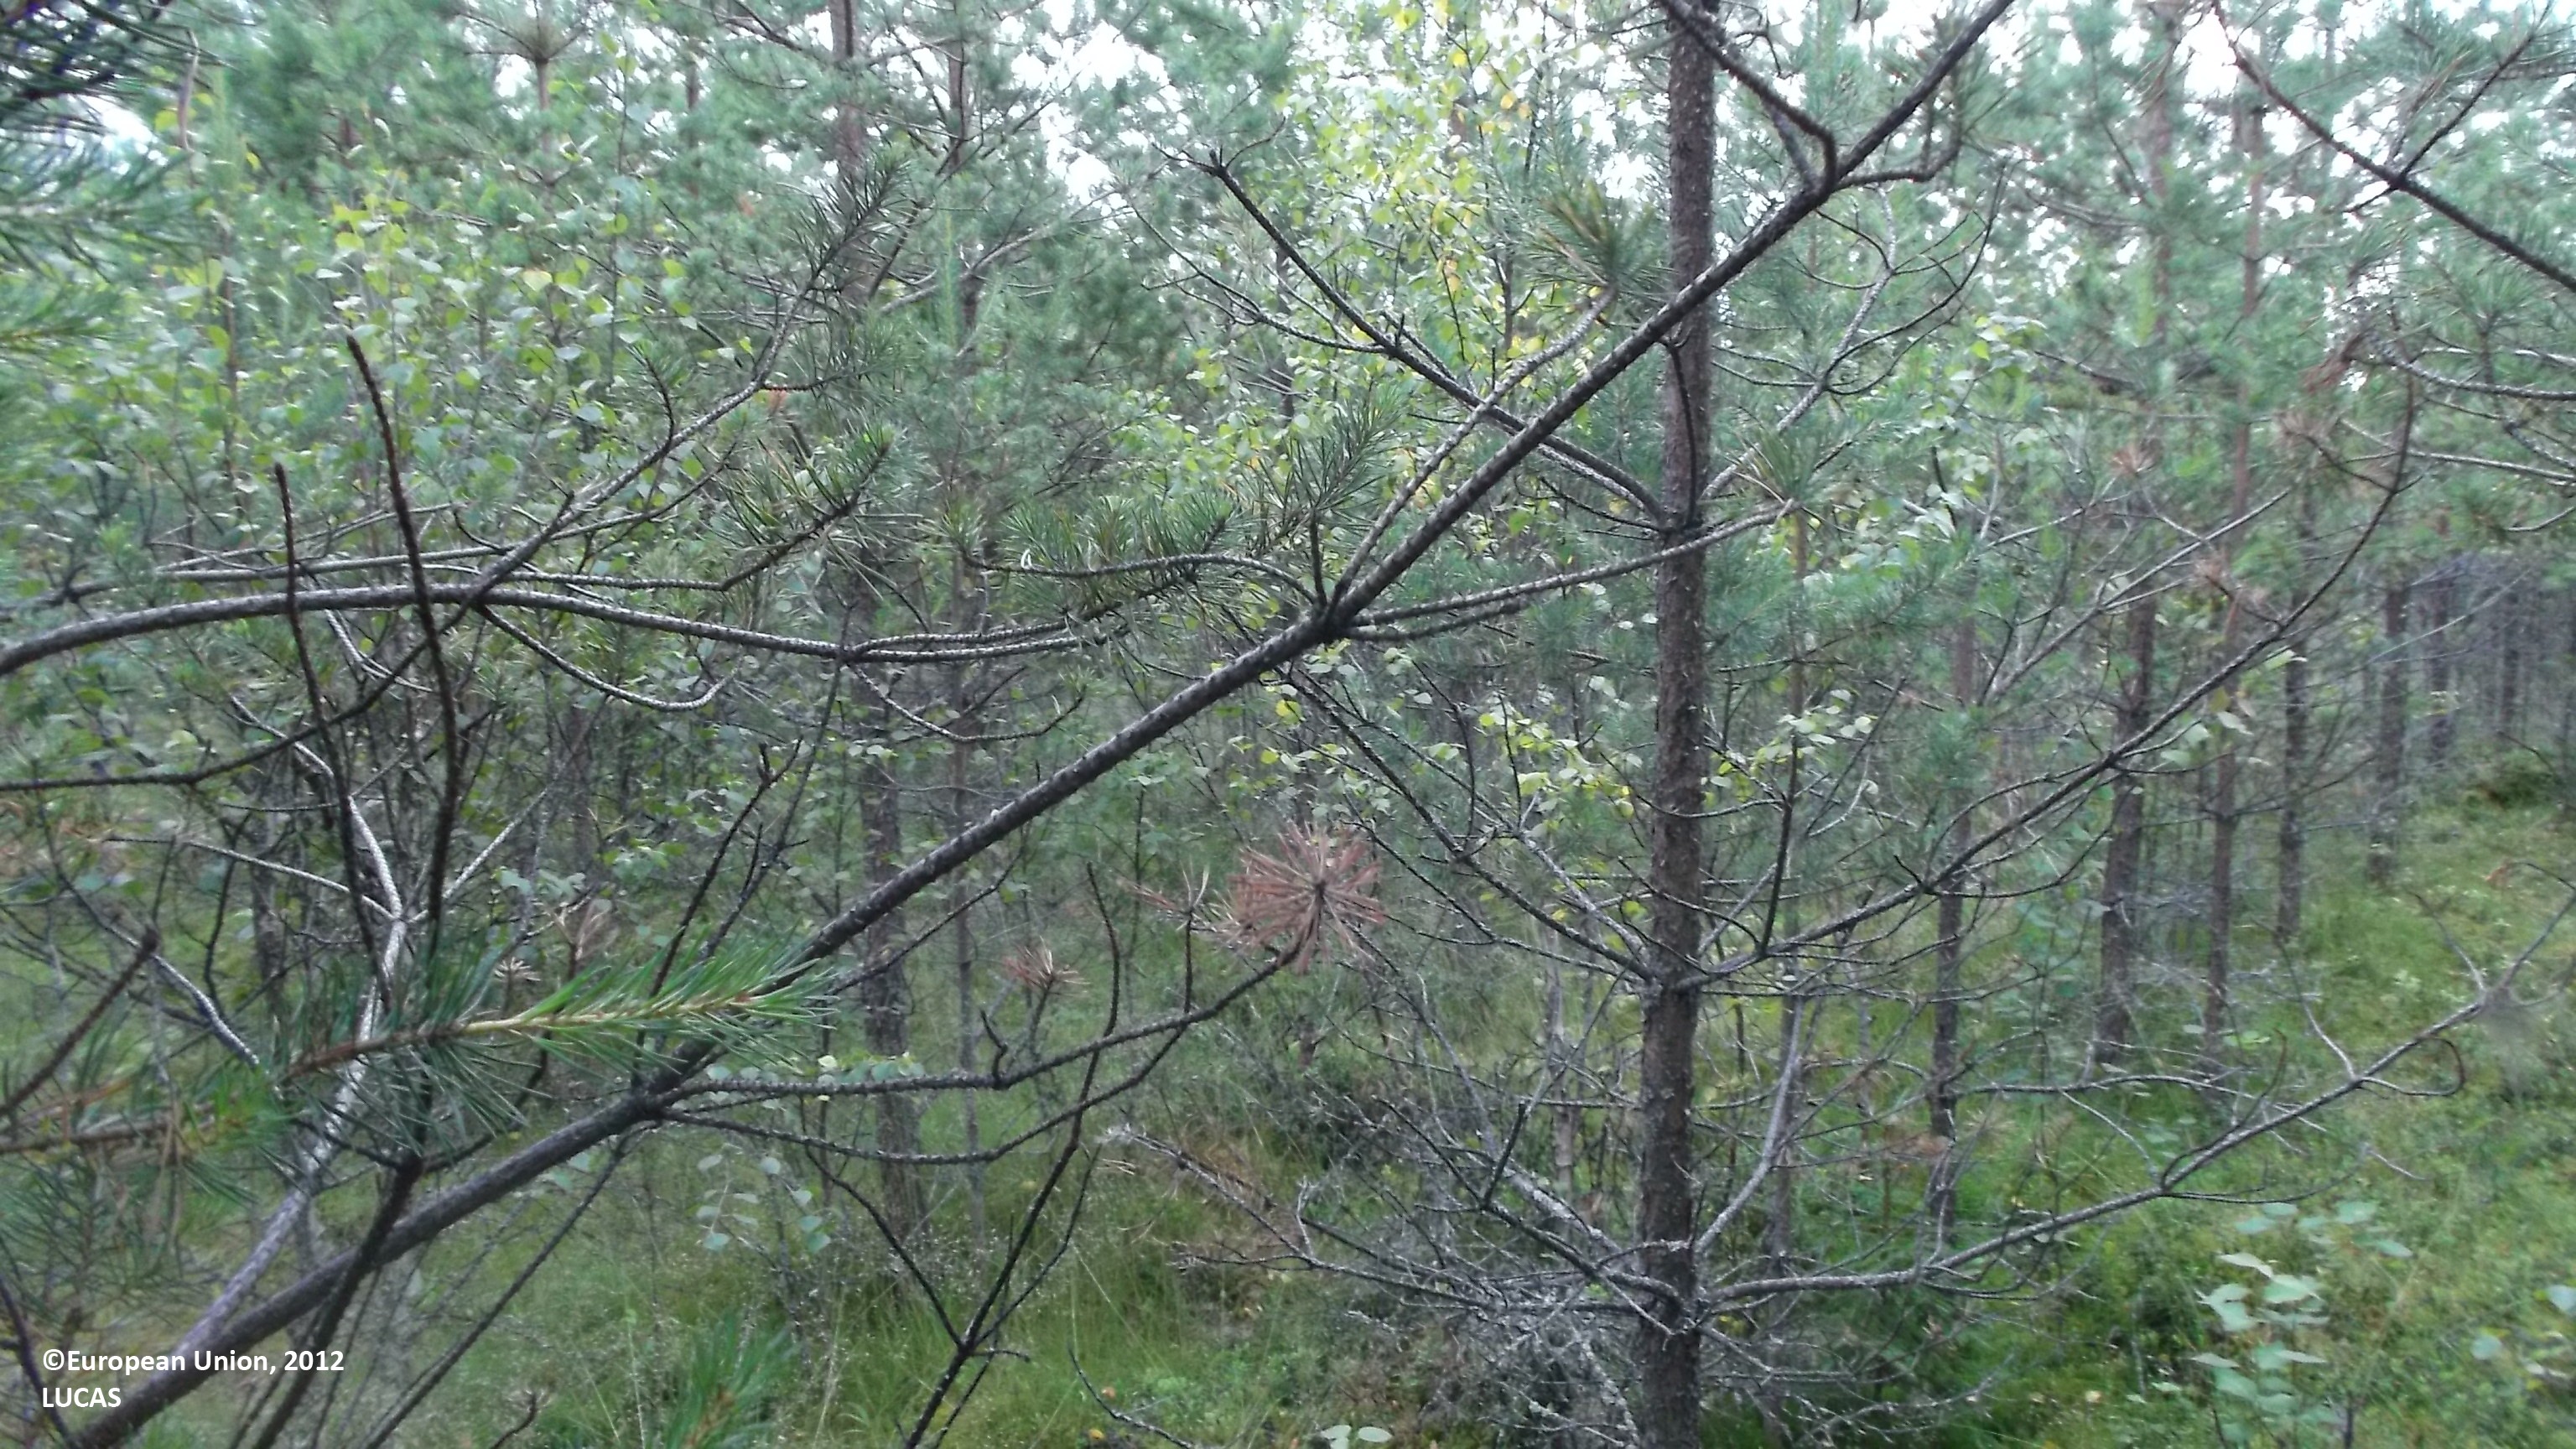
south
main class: Woodland
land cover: Pine dominated mixed woodland
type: boreal forest
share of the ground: > 75 %
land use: Forestry
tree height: > 5 m
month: July
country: FI
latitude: 63.6068
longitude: 23.1821
